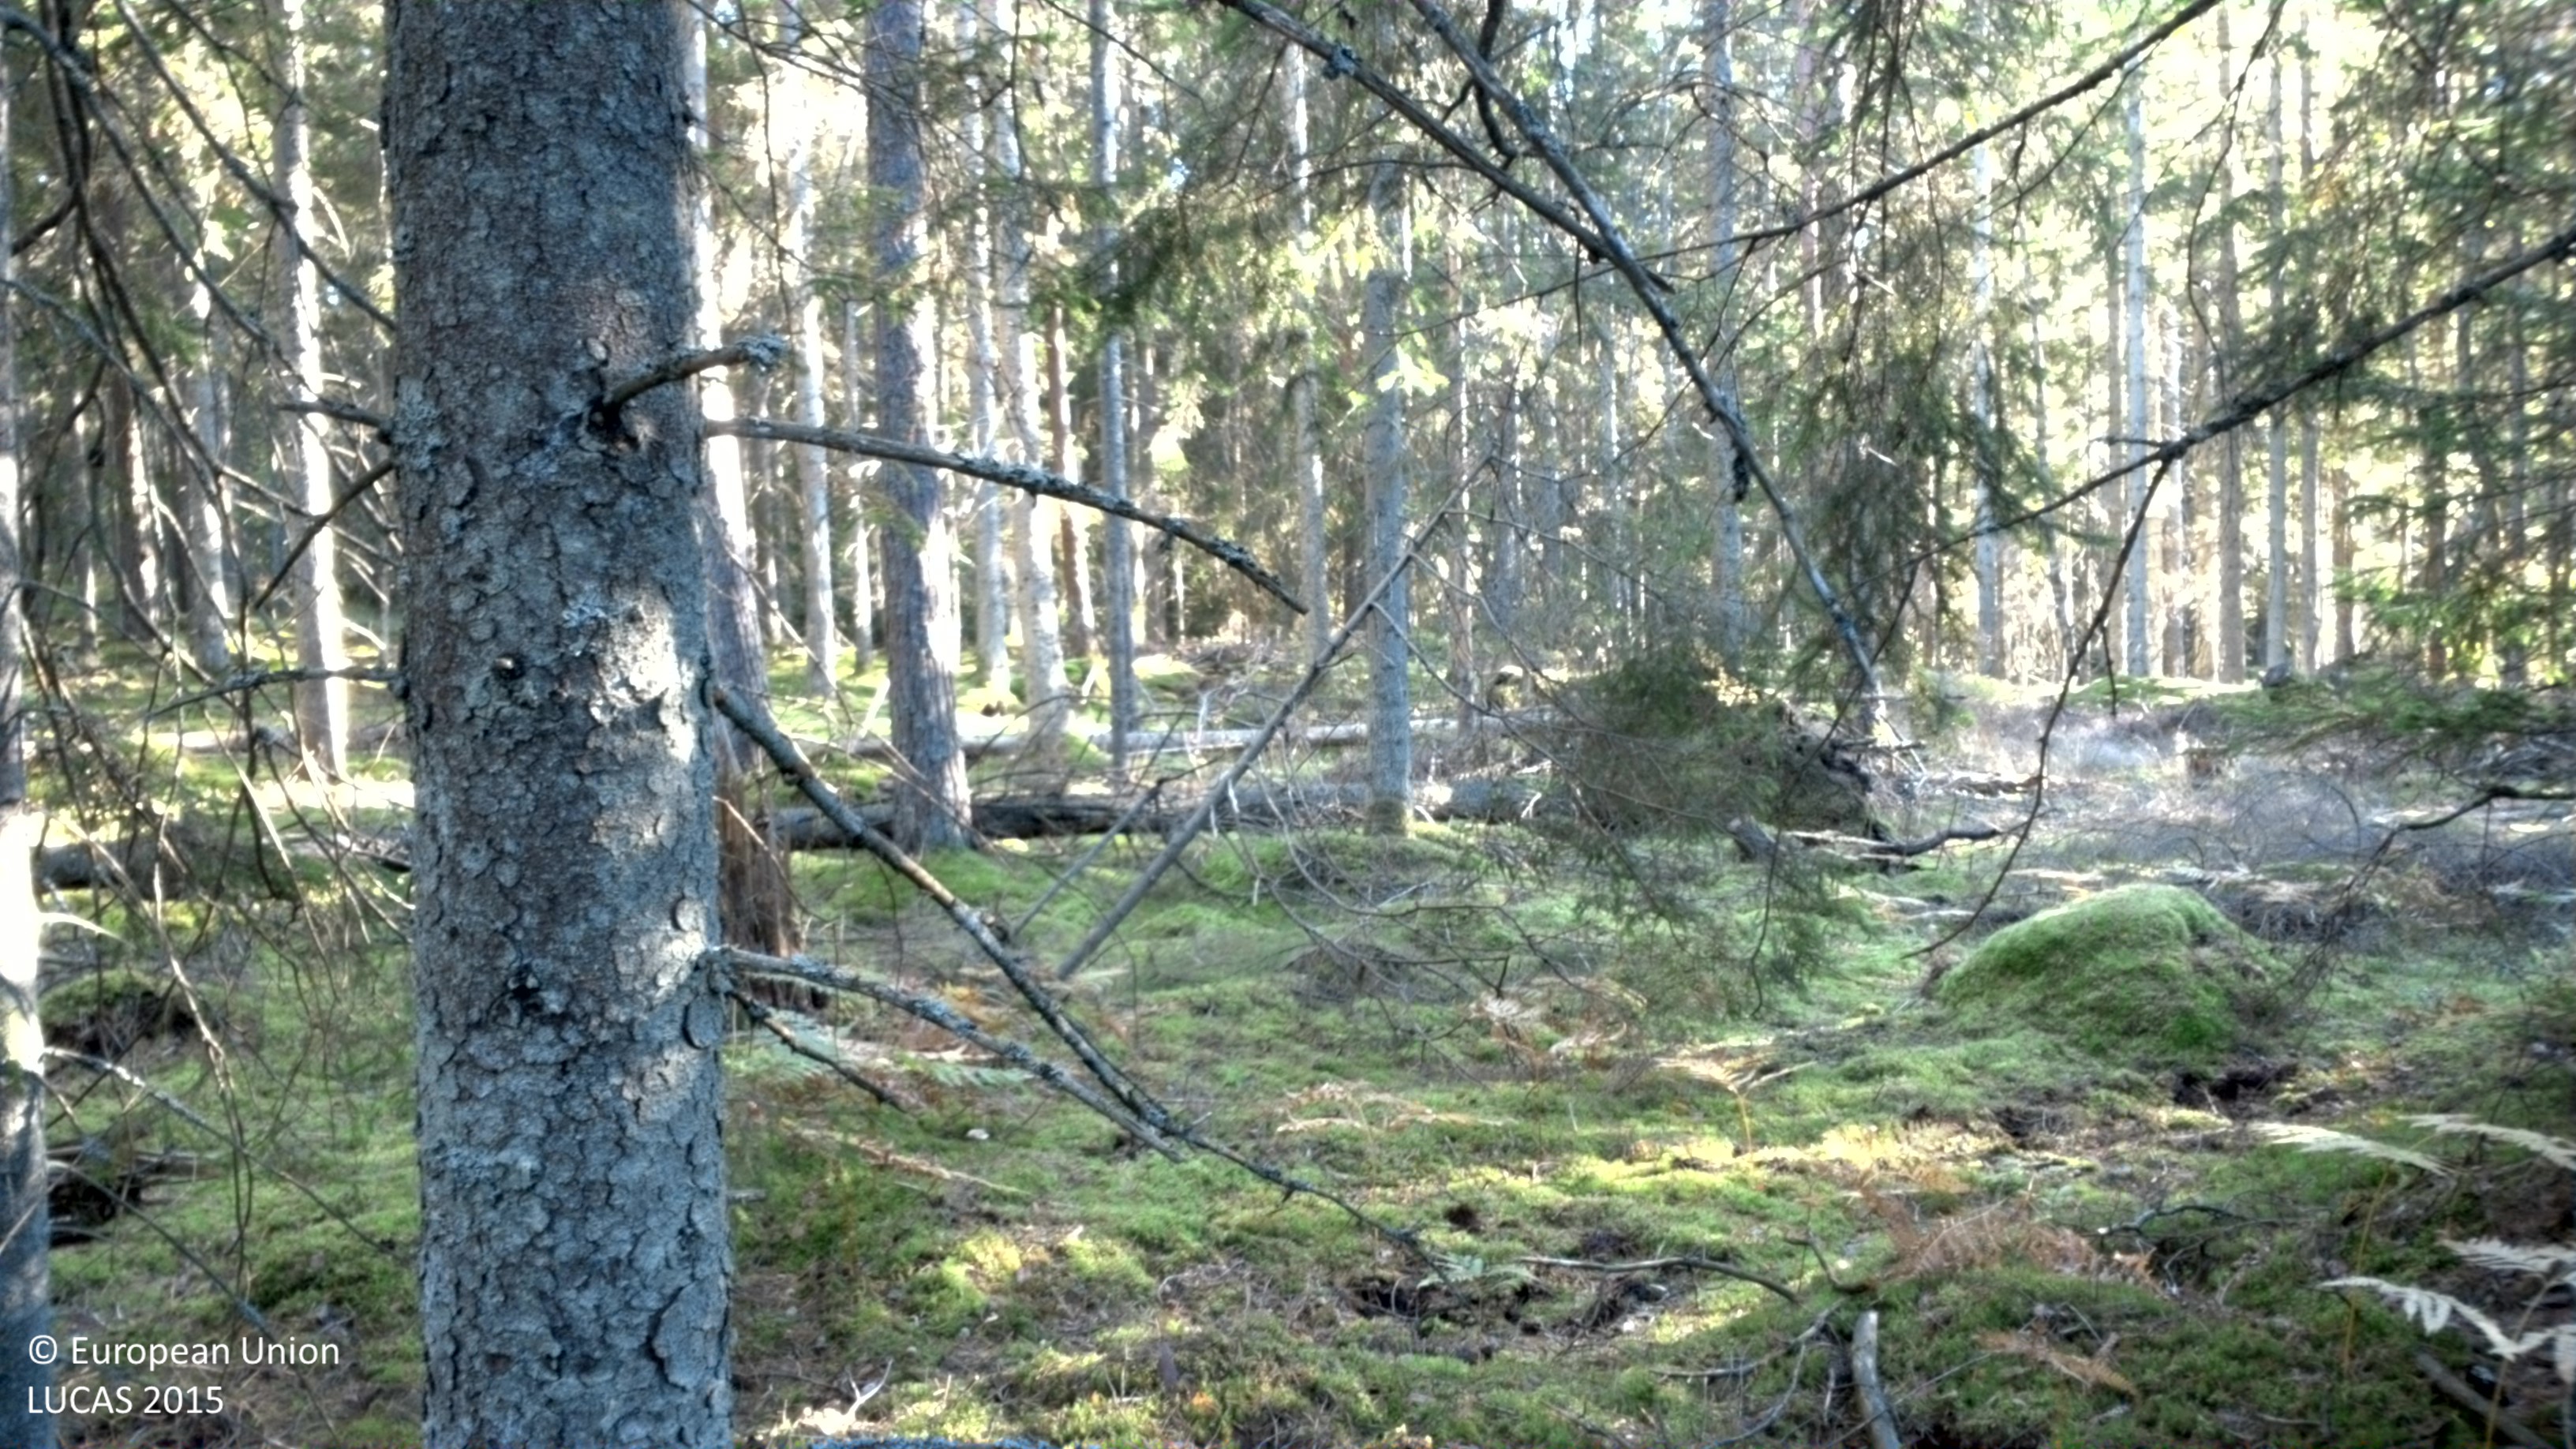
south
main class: Woodland
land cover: Spruce dominated coniferous woodland
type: boreal forest
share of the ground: > 75 %
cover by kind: coniferous forest trees 75 %, lichens and mosses 15 %, shrubs 10 %
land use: Forestry
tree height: > 5 m
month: September
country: SE
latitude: 56.3171
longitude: 15.1885
